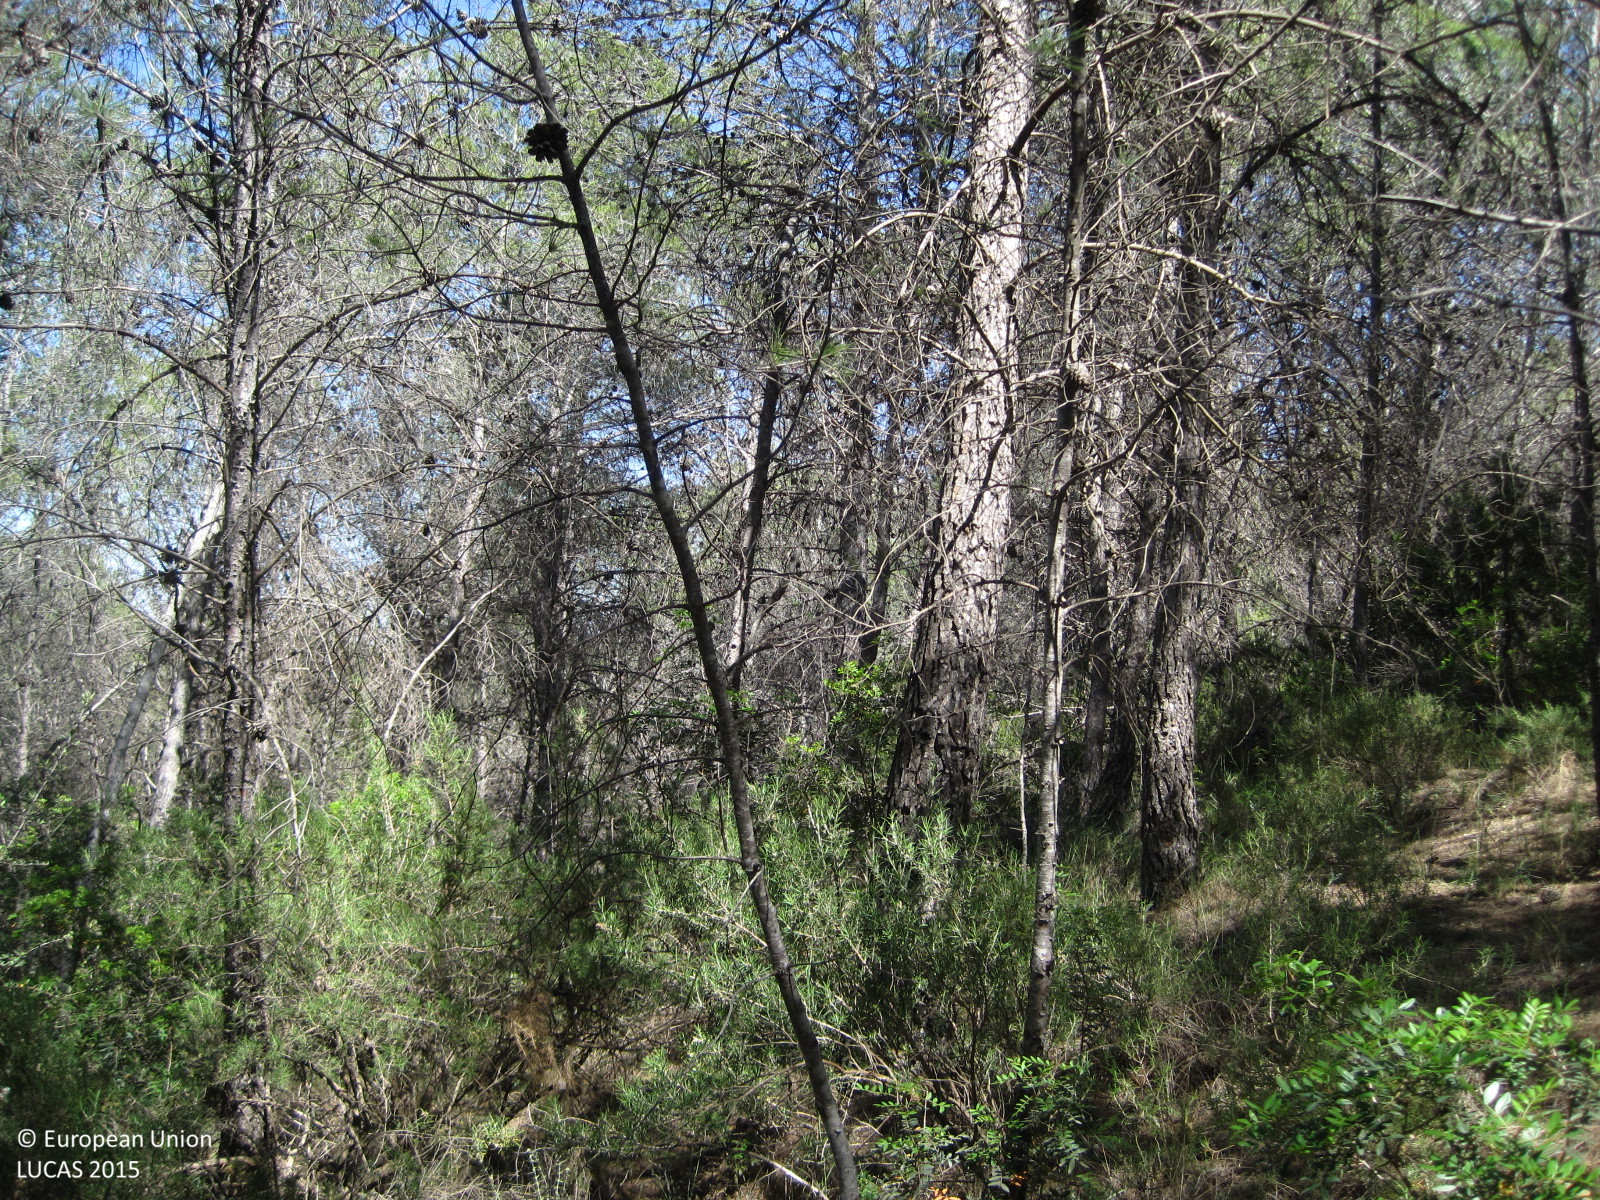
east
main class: Woodland
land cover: Pine dominated coniferous woodland
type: coniferous forest of the mediterranean region
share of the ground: > 75 %
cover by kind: coniferous forest trees 90 %, shrubs 10 %
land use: Semi-natural and natural areas not in use
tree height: > 5 m
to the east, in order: Pine dominated coniferous woodland
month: May
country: ES
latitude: 39.3716
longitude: -0.8517
